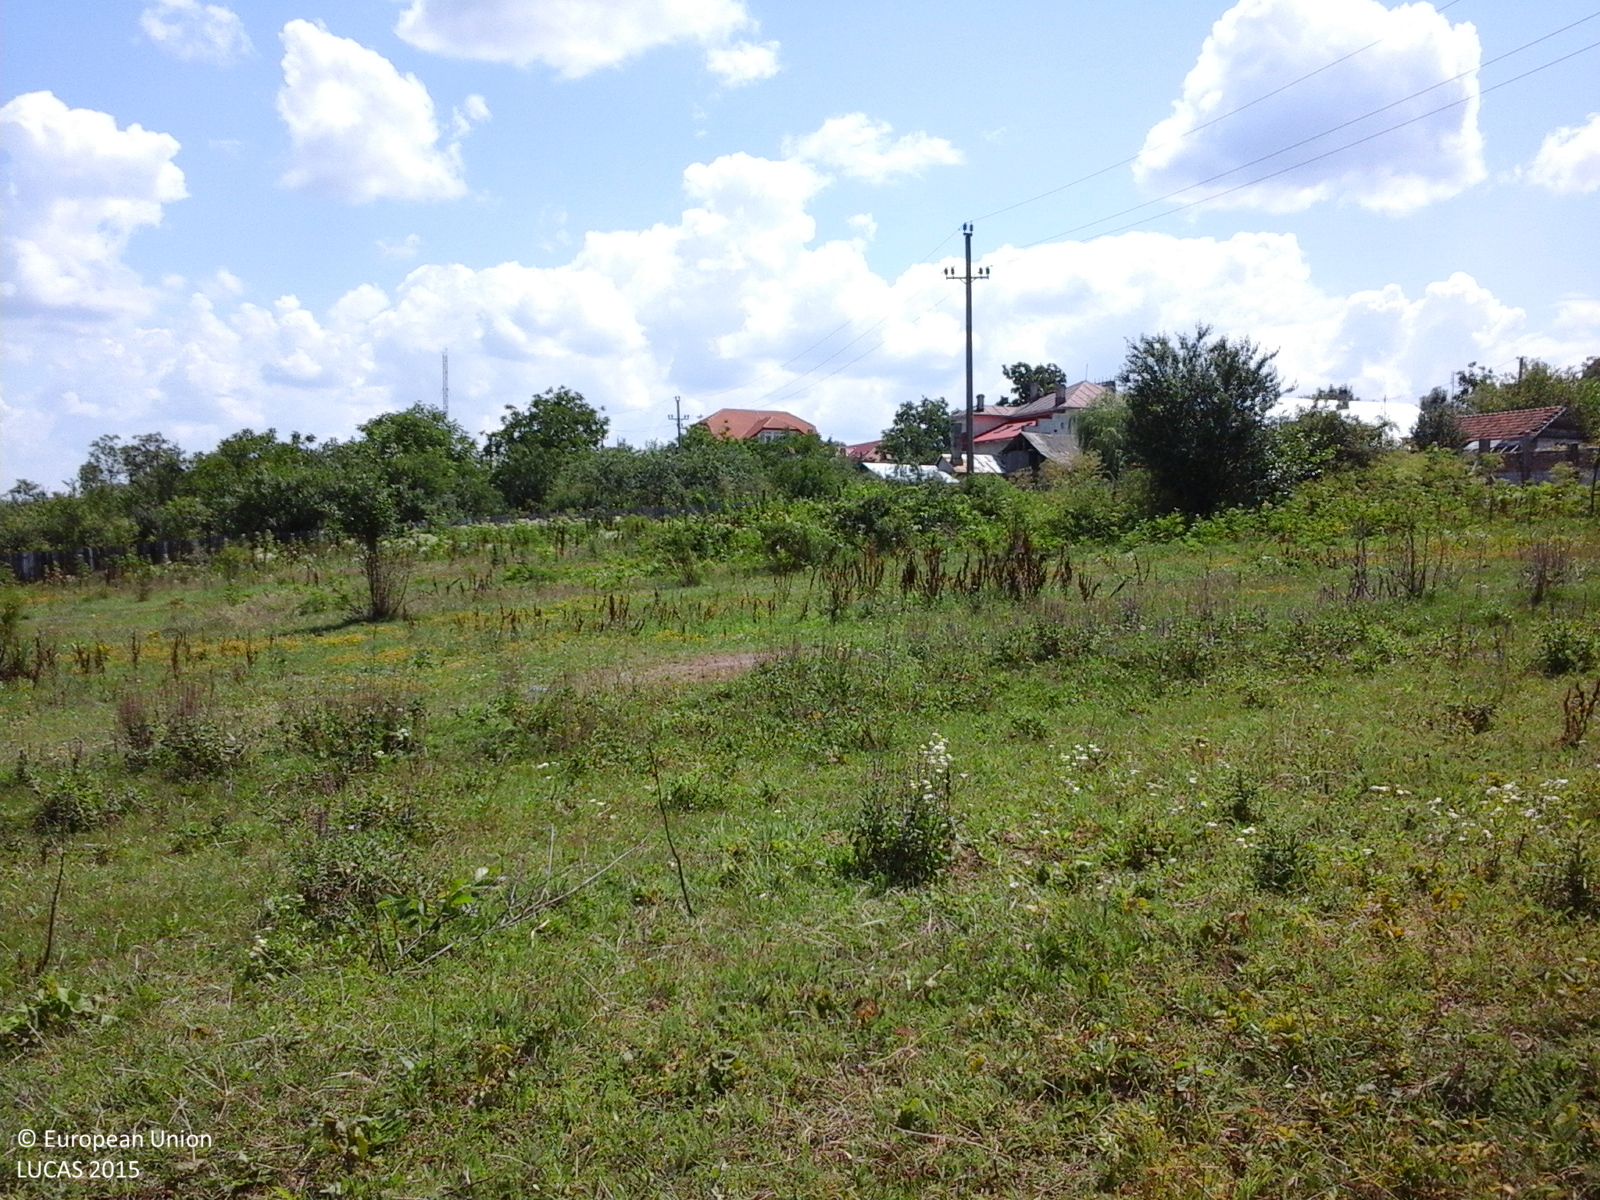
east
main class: Cropland
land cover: Vineyards
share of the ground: 50 - 75 %
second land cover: Grassland without tree/shrub cover
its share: 25 - 50 %
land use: Agriculture (excluding fallow land and kitchen gardens)
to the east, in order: Vineyards; Grassland without tree/shrub cover; Grass margins; Fences; Grassland with sparse tree/shrub cover; Electric lines; Grassland with sparse tree/shrub cover; Broadleaved woodland; Artificial constructions in urban areas
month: July
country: RO
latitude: 44.2366
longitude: 24.7861
